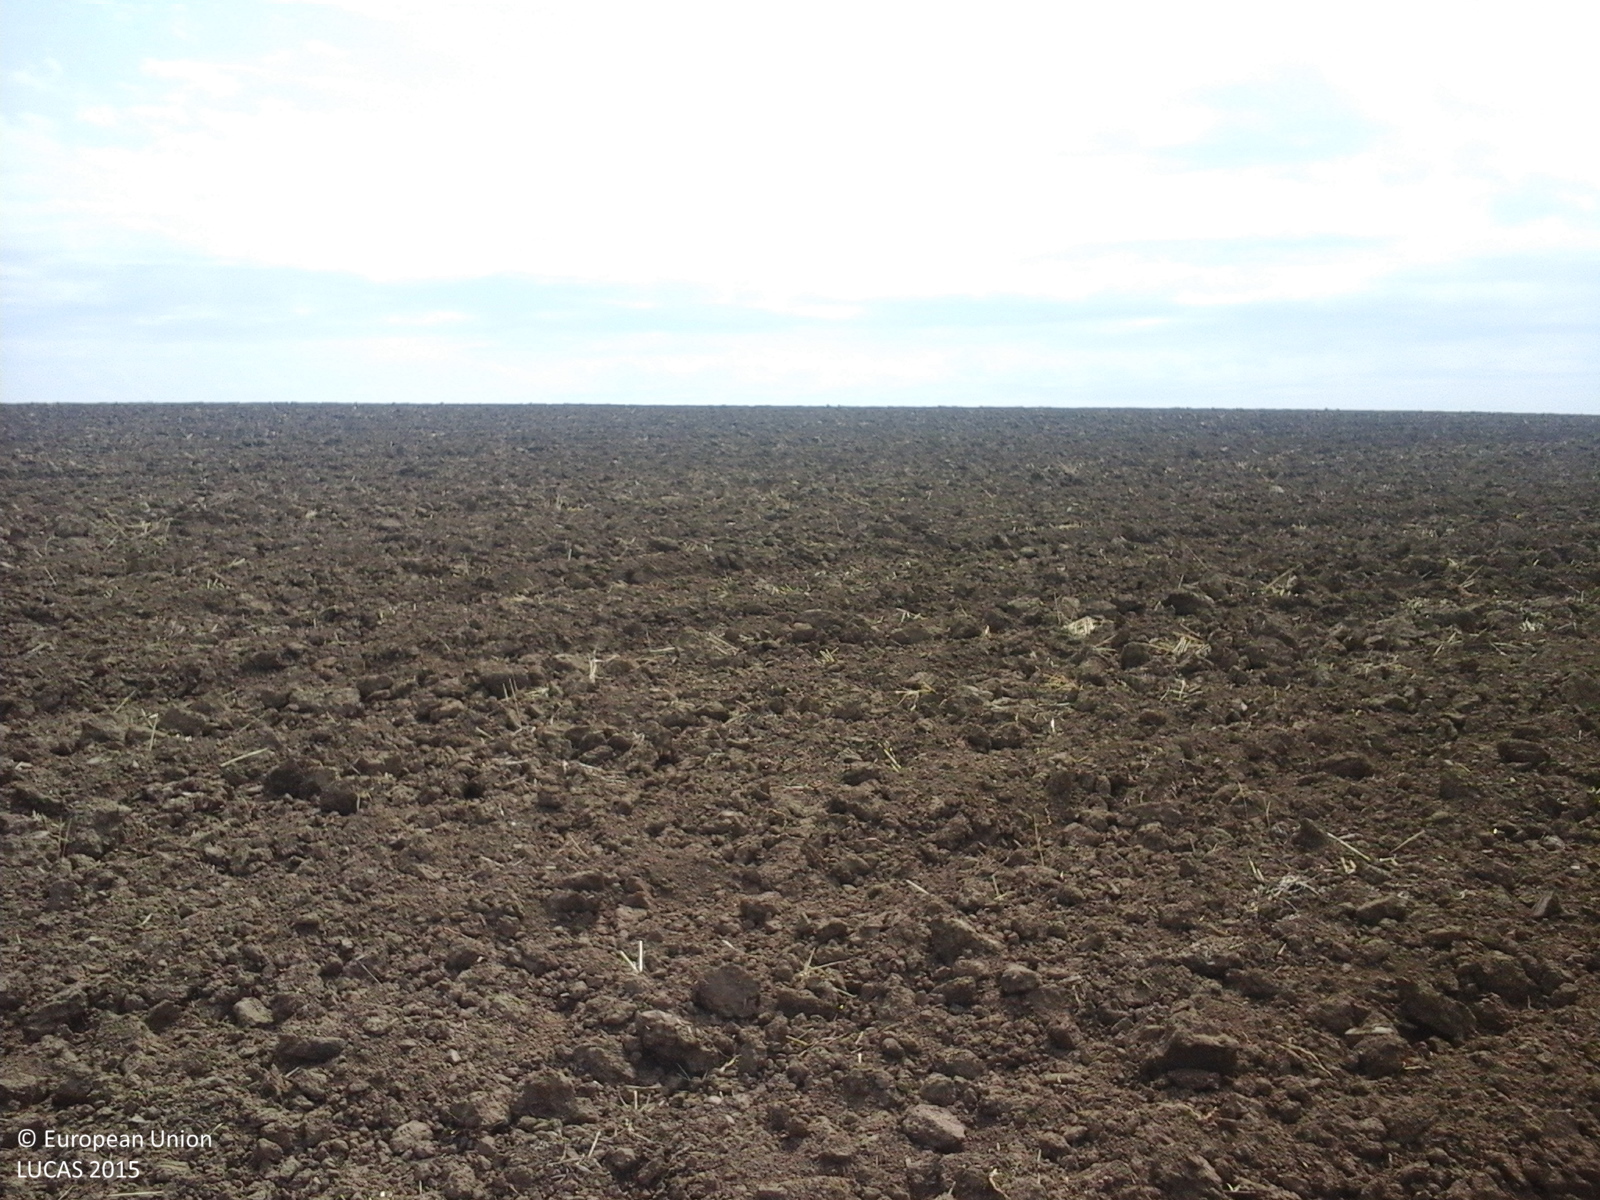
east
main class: Cropland
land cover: Common wheat
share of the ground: < 10 %
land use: Agriculture (excluding fallow land and kitchen gardens)
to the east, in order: Common wheat
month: August
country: RO
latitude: 44.0397
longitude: 27.7531
